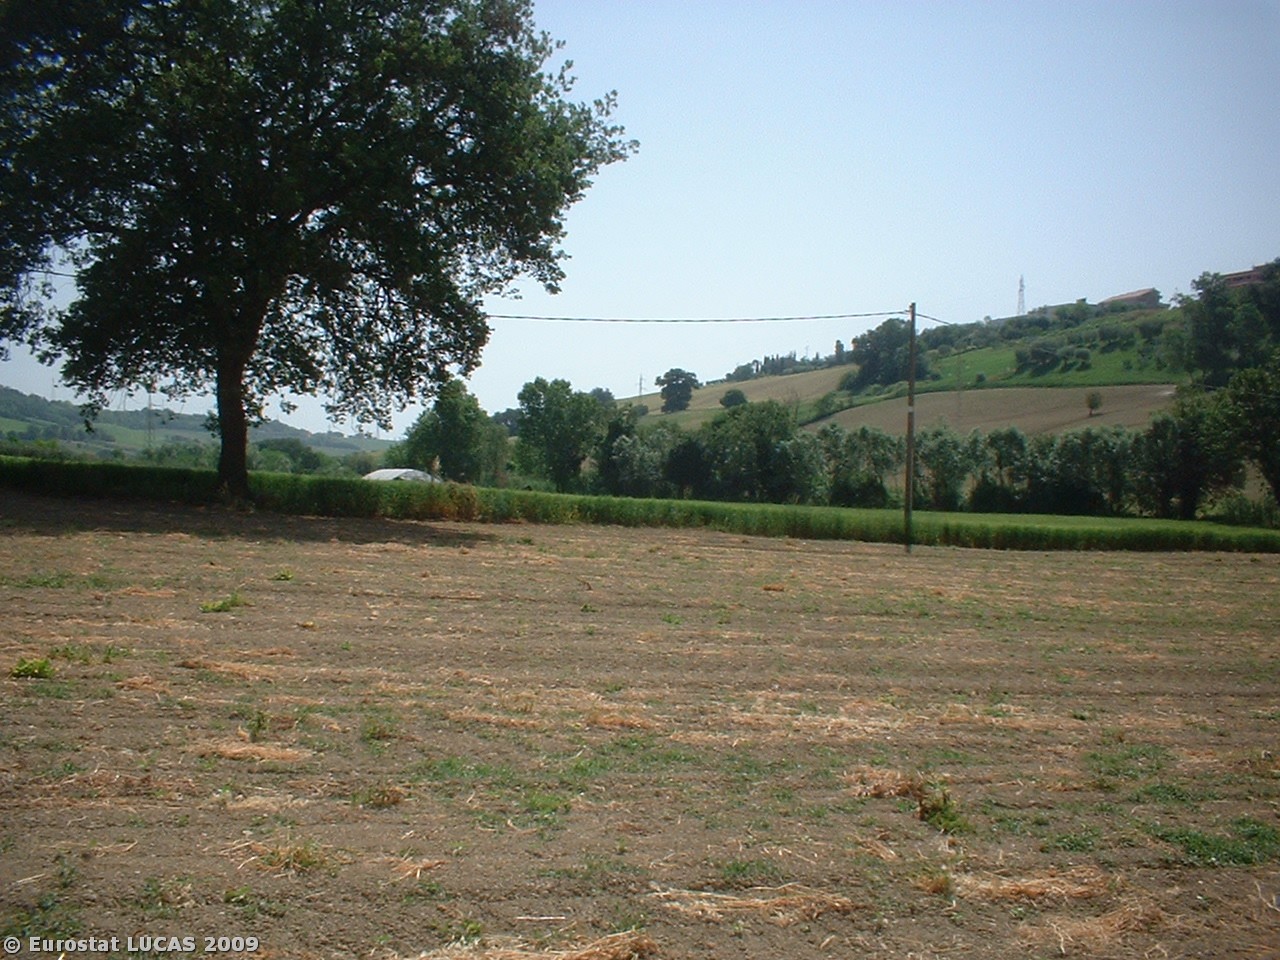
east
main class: Cropland
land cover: Sunflower
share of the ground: < 10 %
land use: Agriculture (excluding fallow land and kitchen gardens)
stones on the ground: < 10 %
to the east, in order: Sunflower; Single bushes/trees; Barley; Grassland without tree/shrub cover; Artificial constructions; Bare land; Grass margins; Fences; Grassland without tree/shrub cover; Bare land
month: May
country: IT
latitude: 43.1633
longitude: 13.7416
